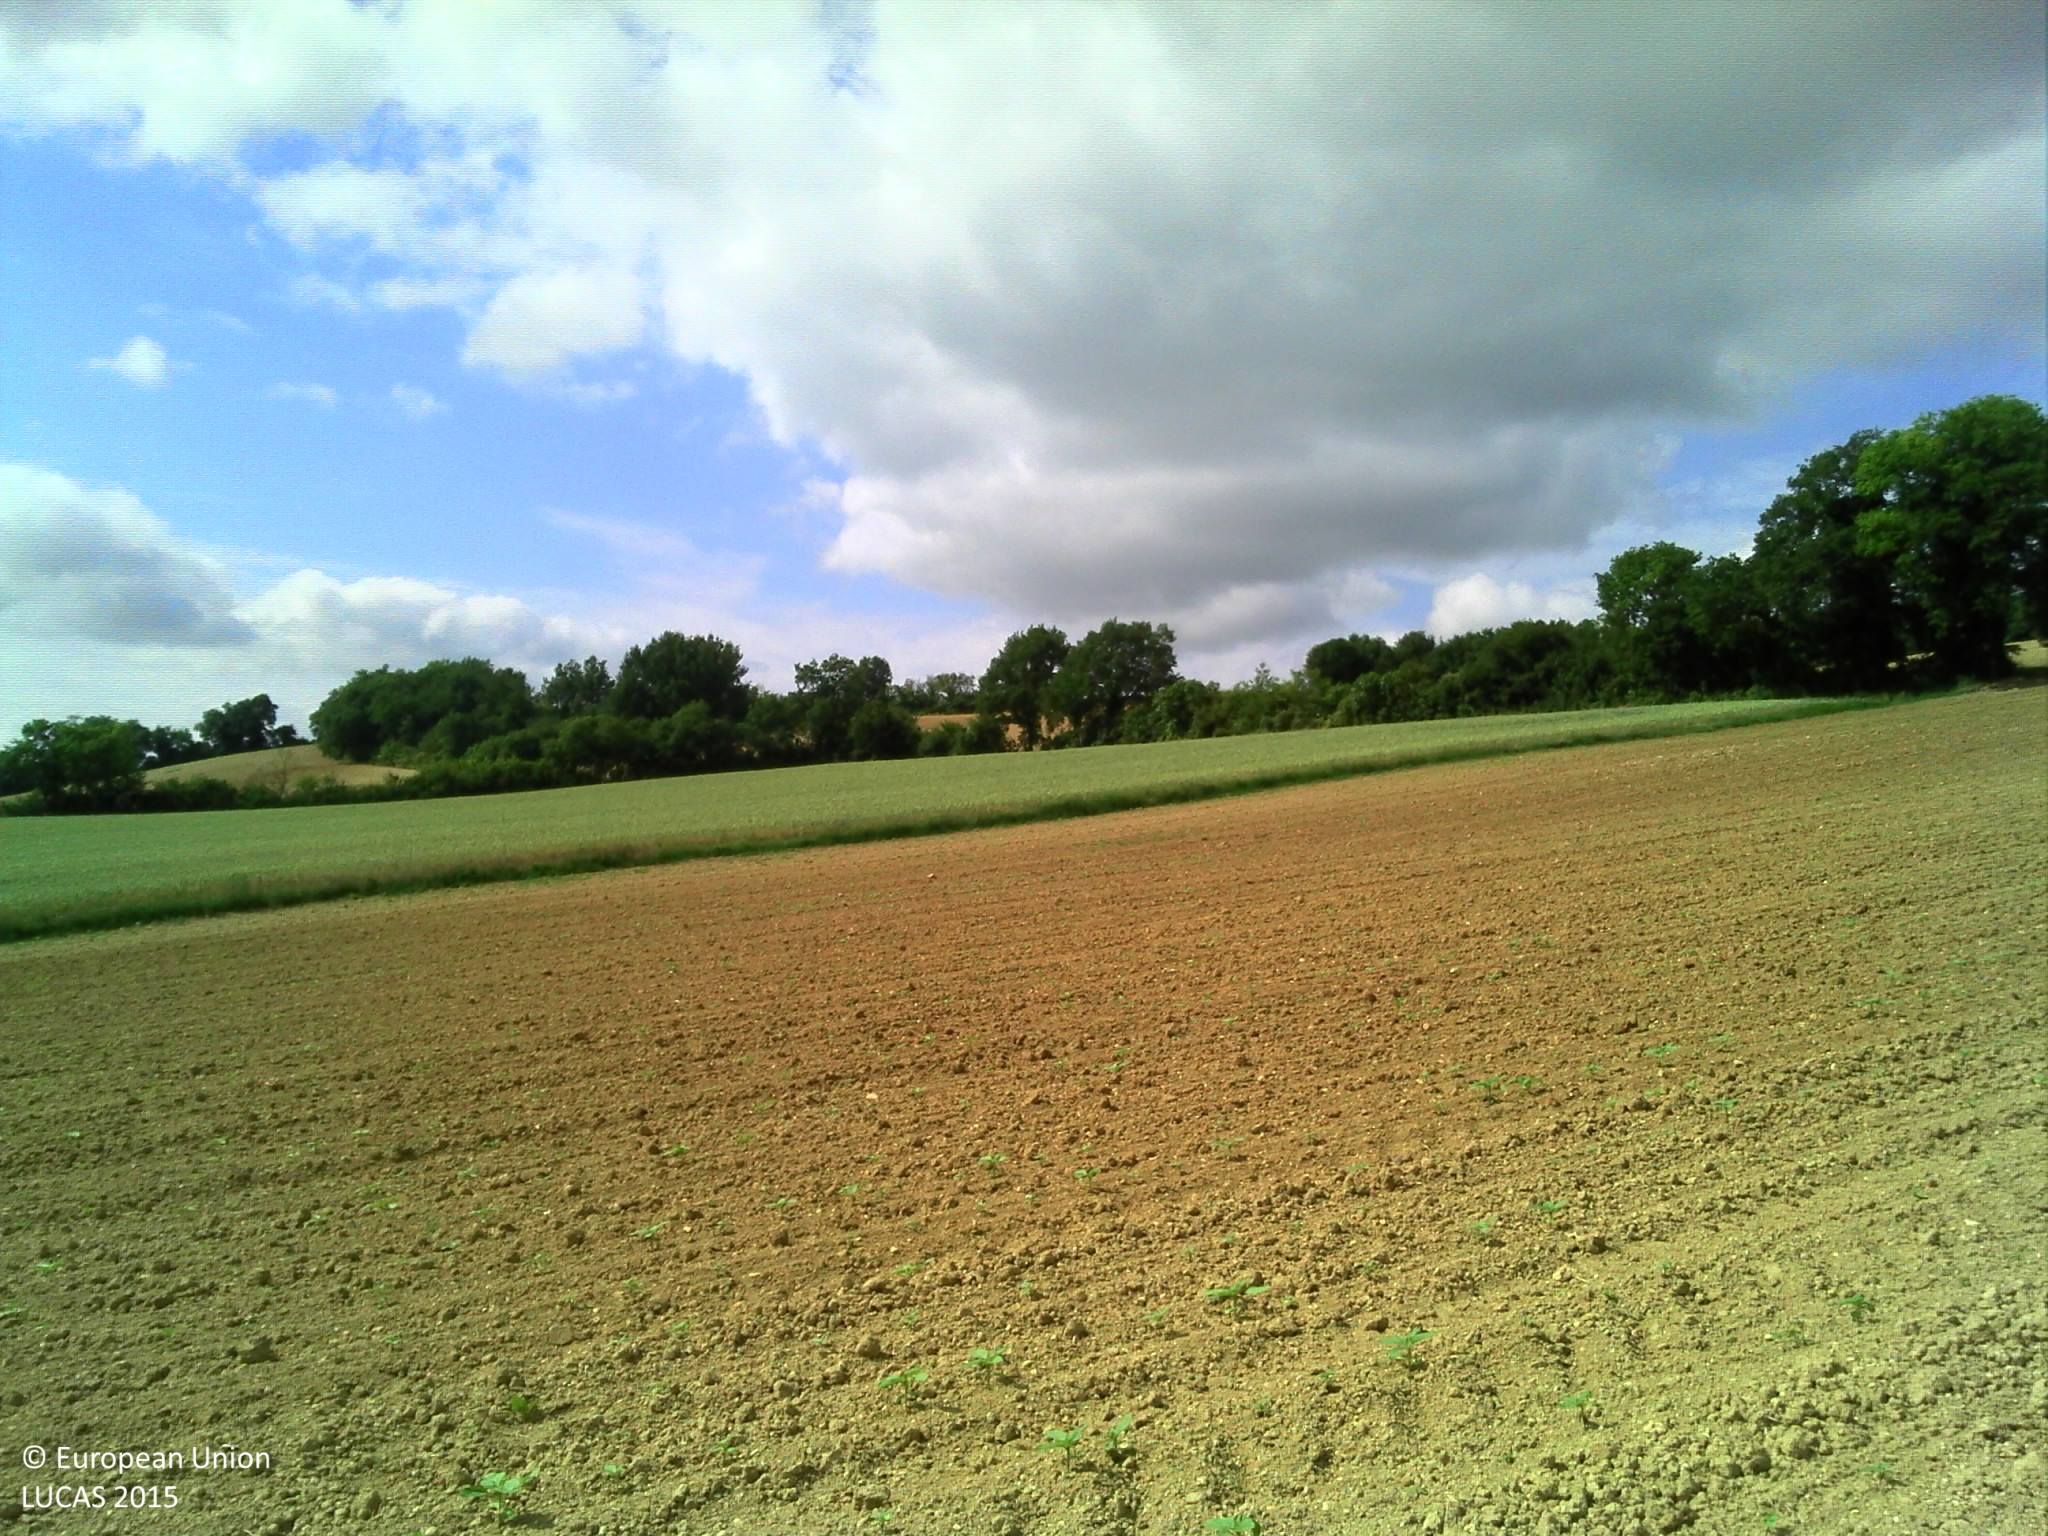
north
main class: Cropland
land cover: Sunflower
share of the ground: < 10 %
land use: Agriculture (excluding fallow land and kitchen gardens)
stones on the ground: < 10 %
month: June
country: FR
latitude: 43.5692
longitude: 0.7003
